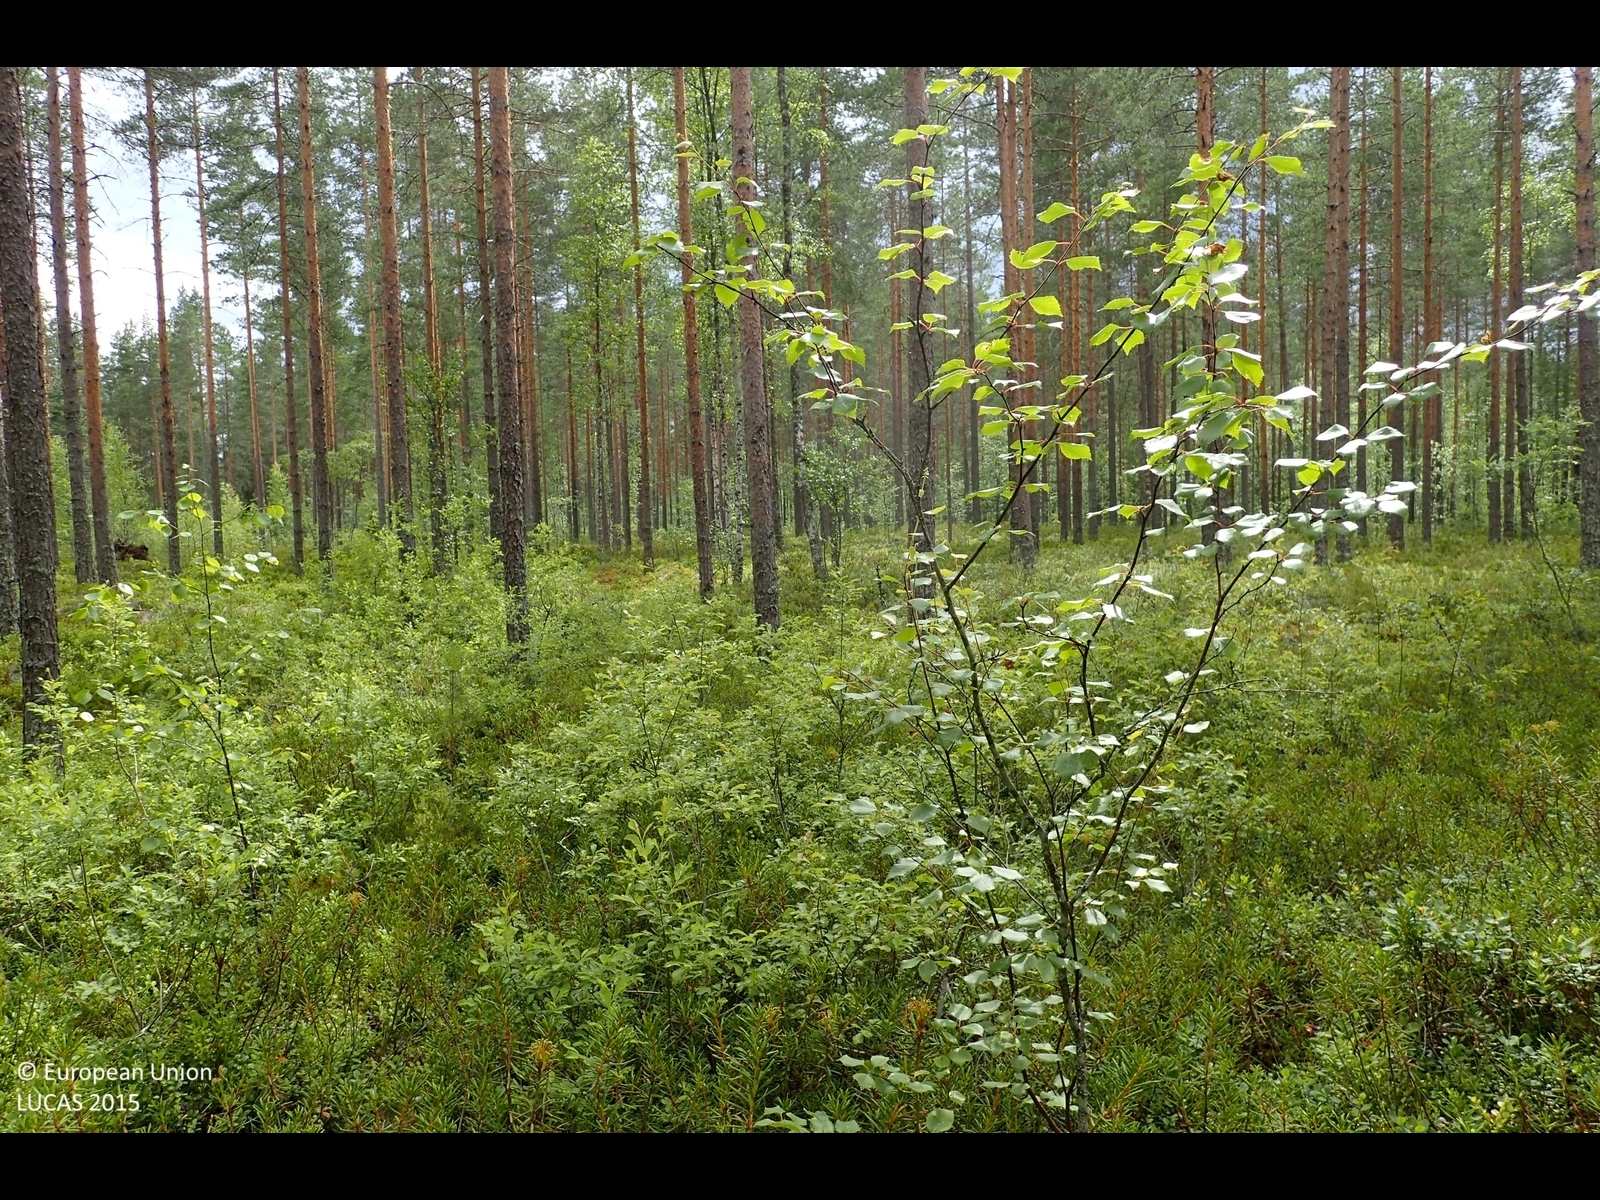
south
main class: Woodland
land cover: Pine dominated coniferous woodland
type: boreal forest
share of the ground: 50 - 75 %
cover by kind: coniferous forest trees 45 %, shrubs 45 %, broadleaved forest trees 5 %, lichens and mosses 5 %
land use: Forestry
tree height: > 5 m
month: July
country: FI
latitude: 62.6067
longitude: 23.4933
